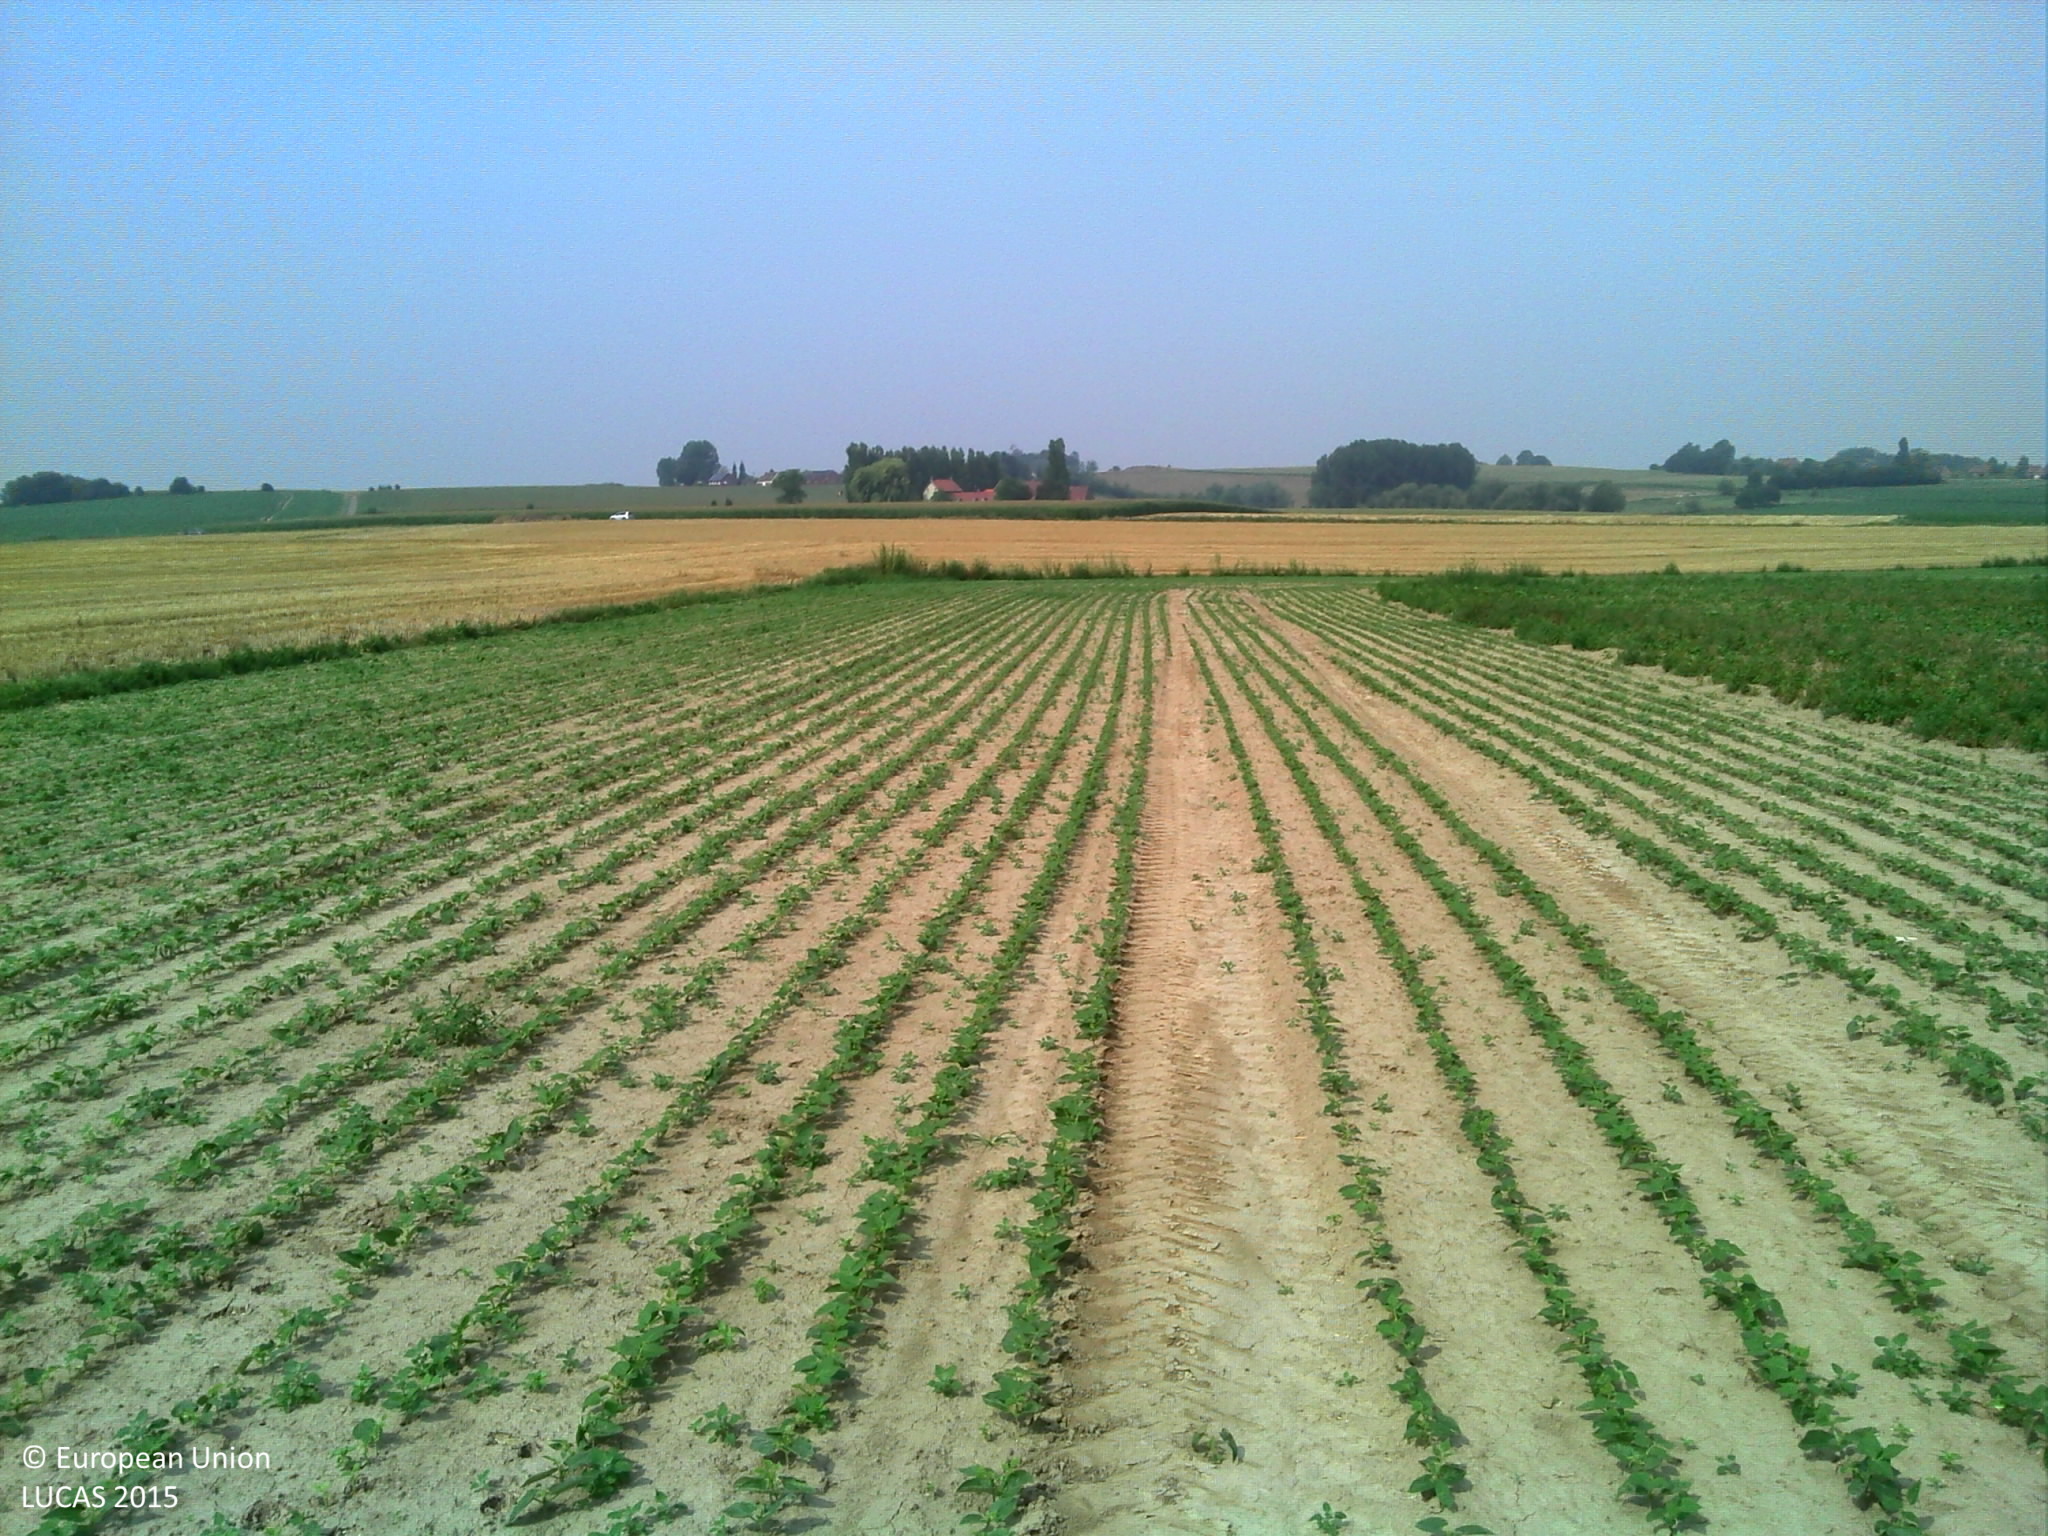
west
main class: Cropland
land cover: Other fresh vegetables
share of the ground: < 10 %
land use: Agriculture (excluding fallow land and kitchen gardens)
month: August
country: BE
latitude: 50.6319
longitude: 3.5314
